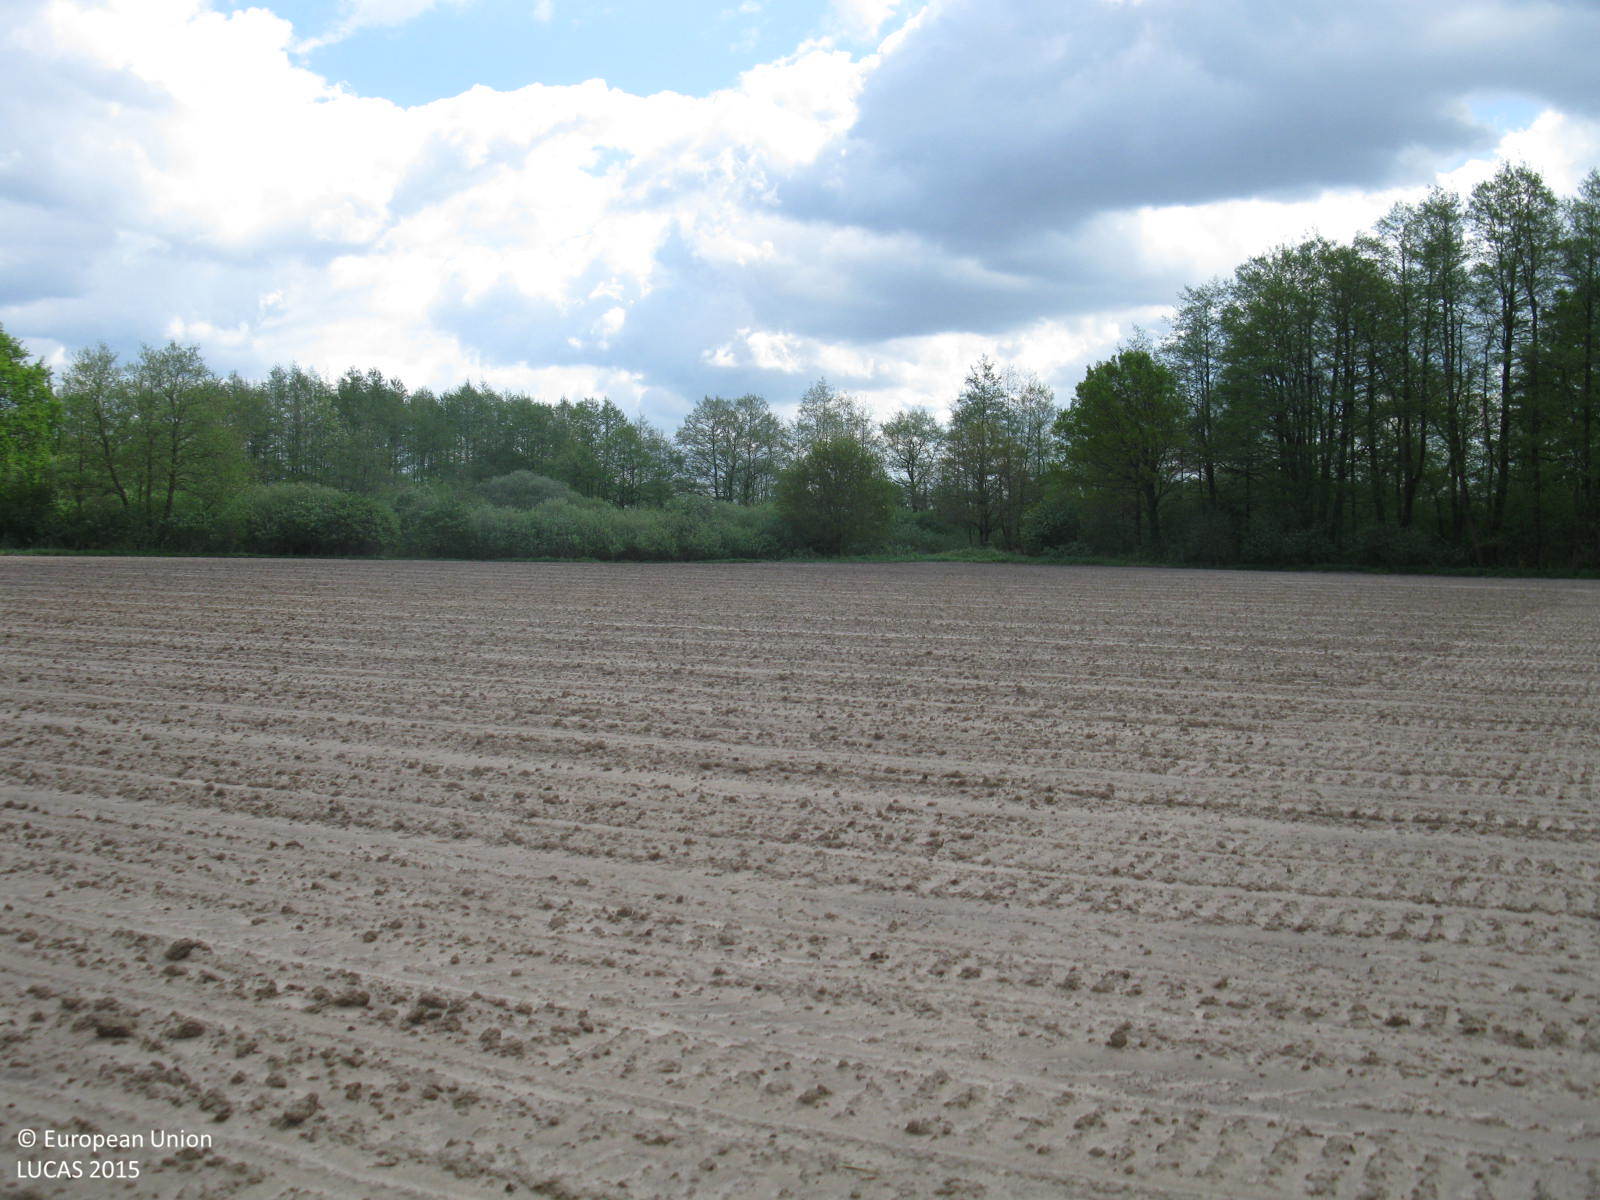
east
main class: Cropland
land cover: Maize
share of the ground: < 10 %
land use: Agriculture (excluding fallow land and kitchen gardens)
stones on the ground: < 10 %
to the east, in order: Maize; Broadleaved woodland; Ditches and canals; Broadleaved woodland; Rivers and streams; Shruby margins; Maize
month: May
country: DE
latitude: 52.9225
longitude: 7.3083
